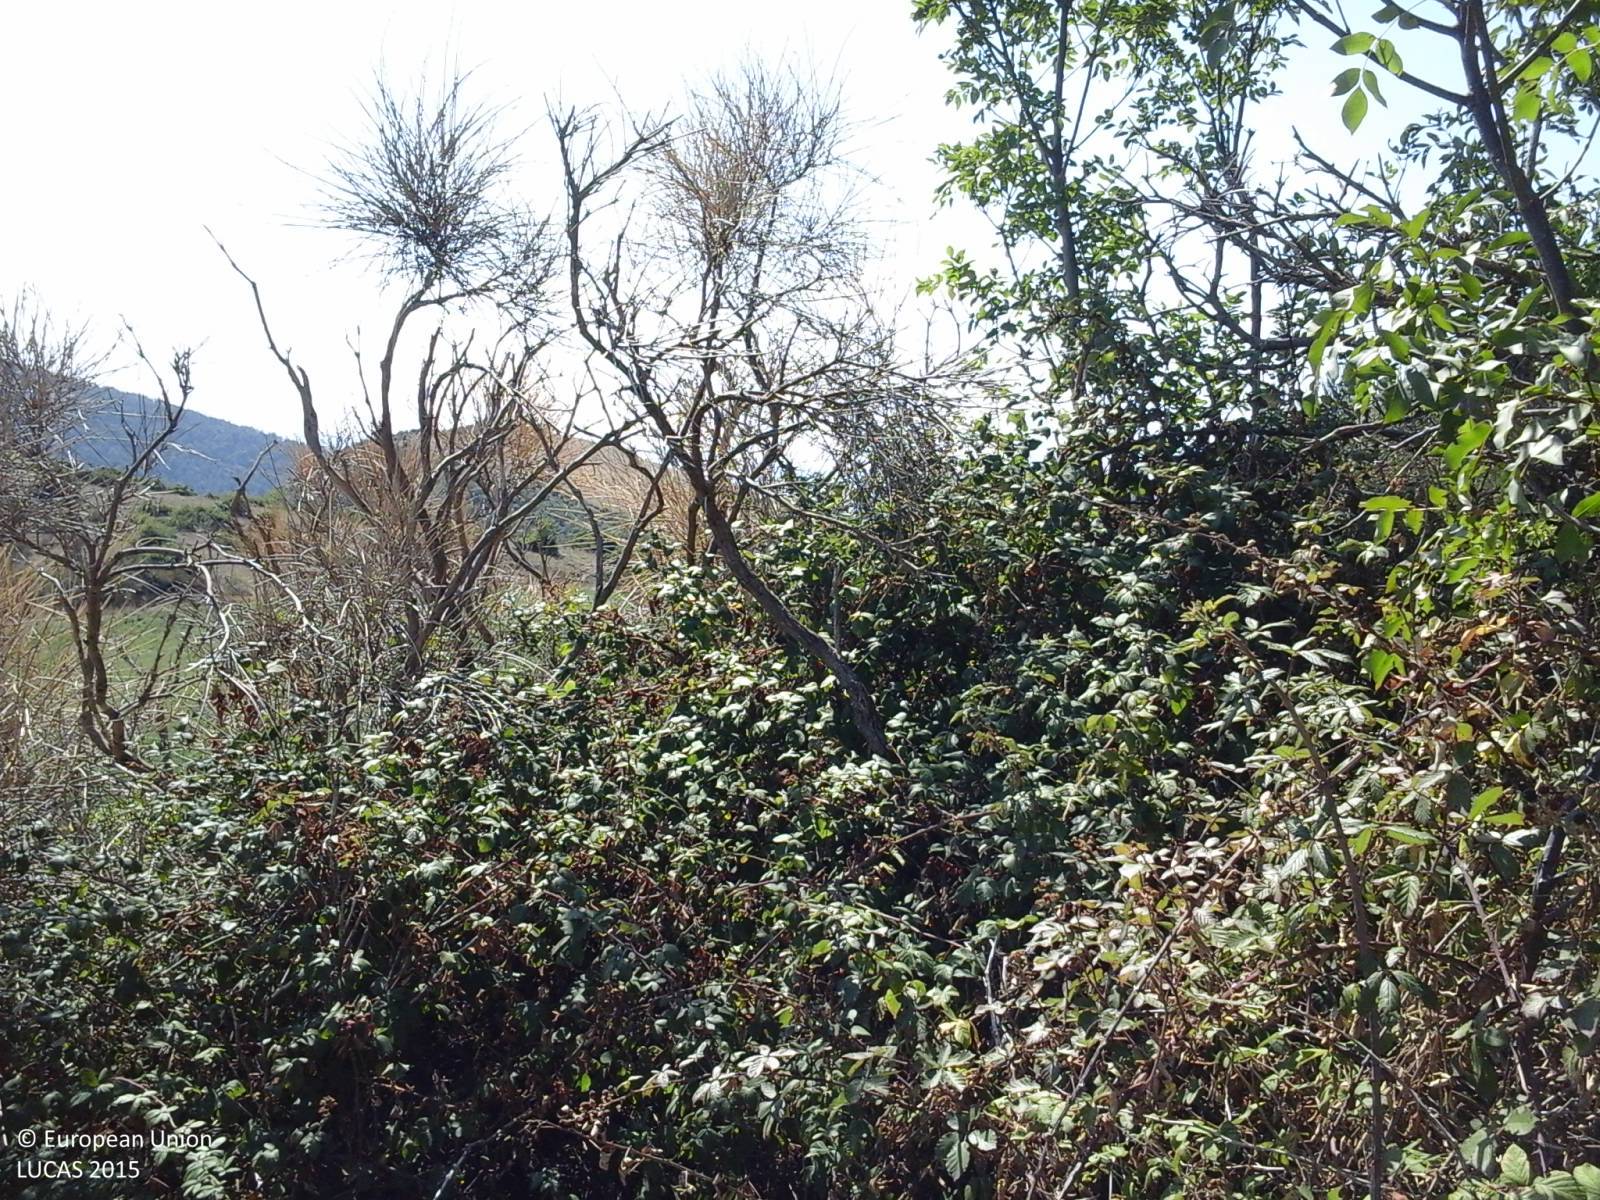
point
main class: Shrubland
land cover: Shrubland with sparse tree cover
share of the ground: > 75 %
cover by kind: shrubs 75 %, herbaceous plants 20 %, broadleaved forest trees 5 %
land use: Semi-natural and natural areas not in use
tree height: < 5 m
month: September
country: IT
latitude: 43.0895
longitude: 12.6336
